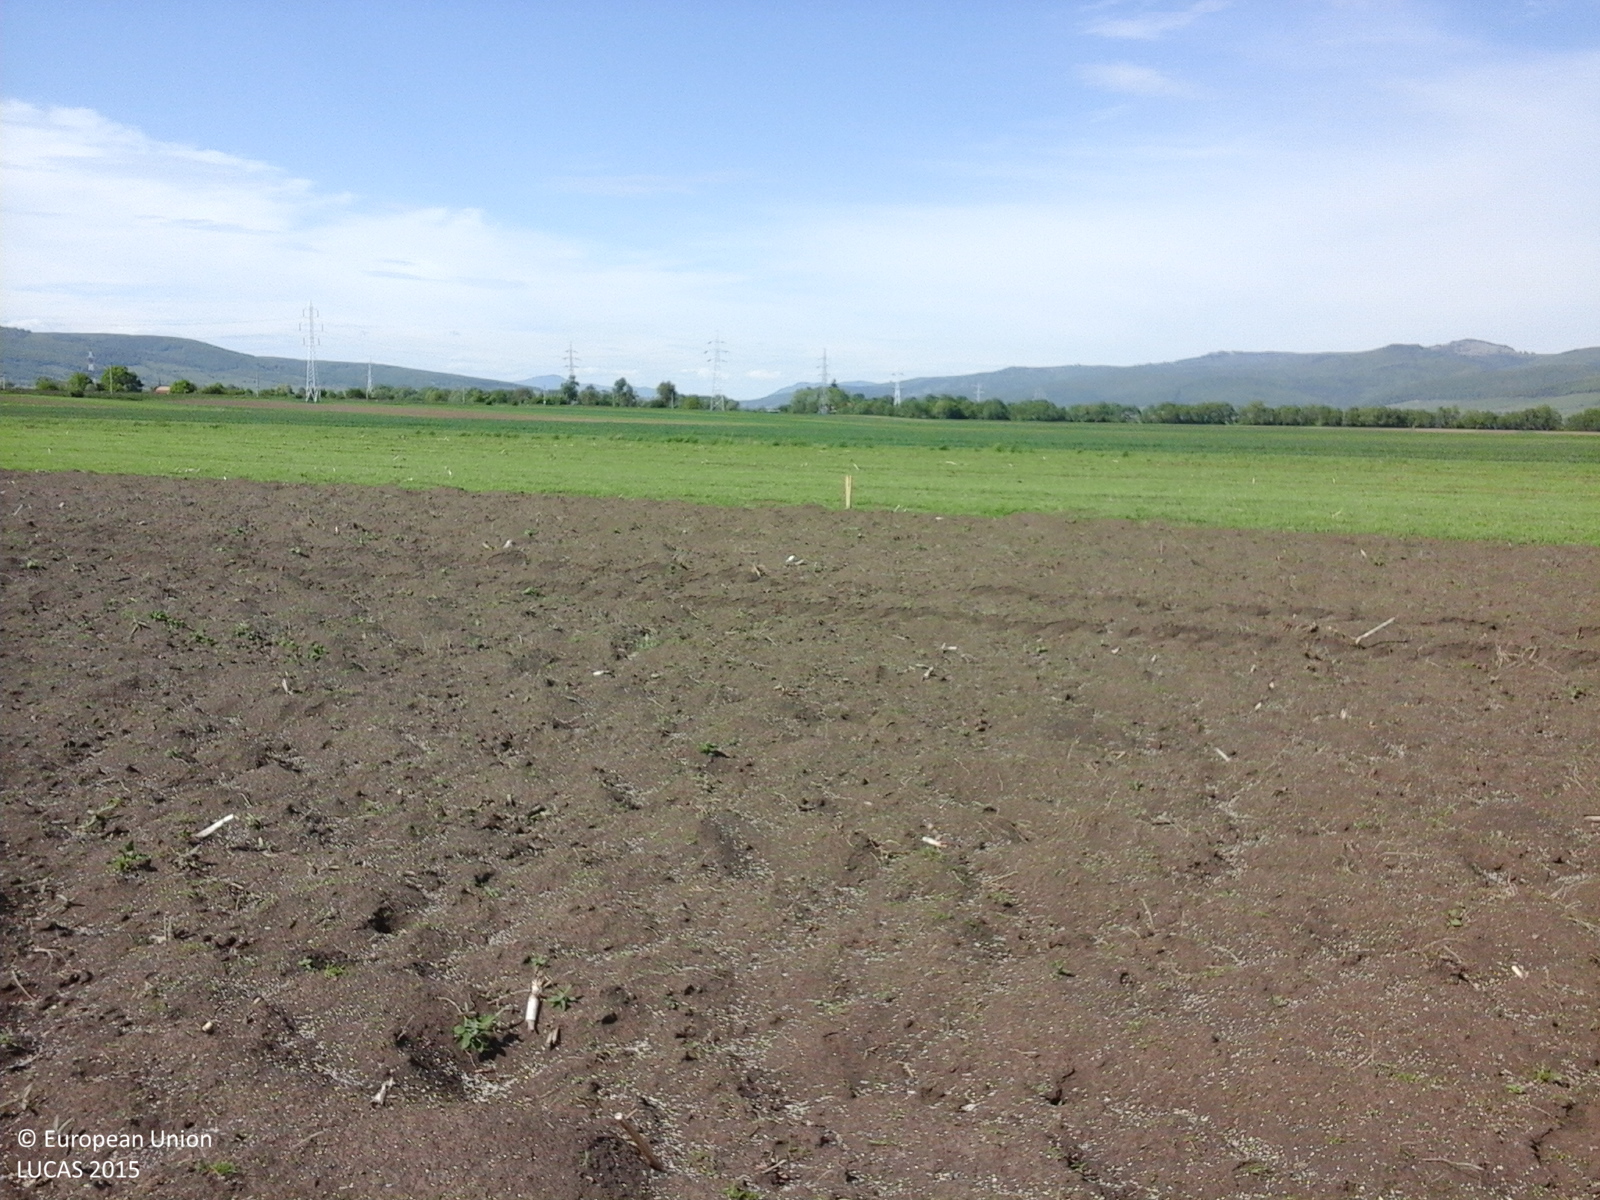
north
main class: Cropland
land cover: Maize
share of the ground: < 10 %
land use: Agriculture (excluding fallow land and kitchen gardens)
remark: Harvested field
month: May
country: RO
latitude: 45.8976
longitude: 25.8231
